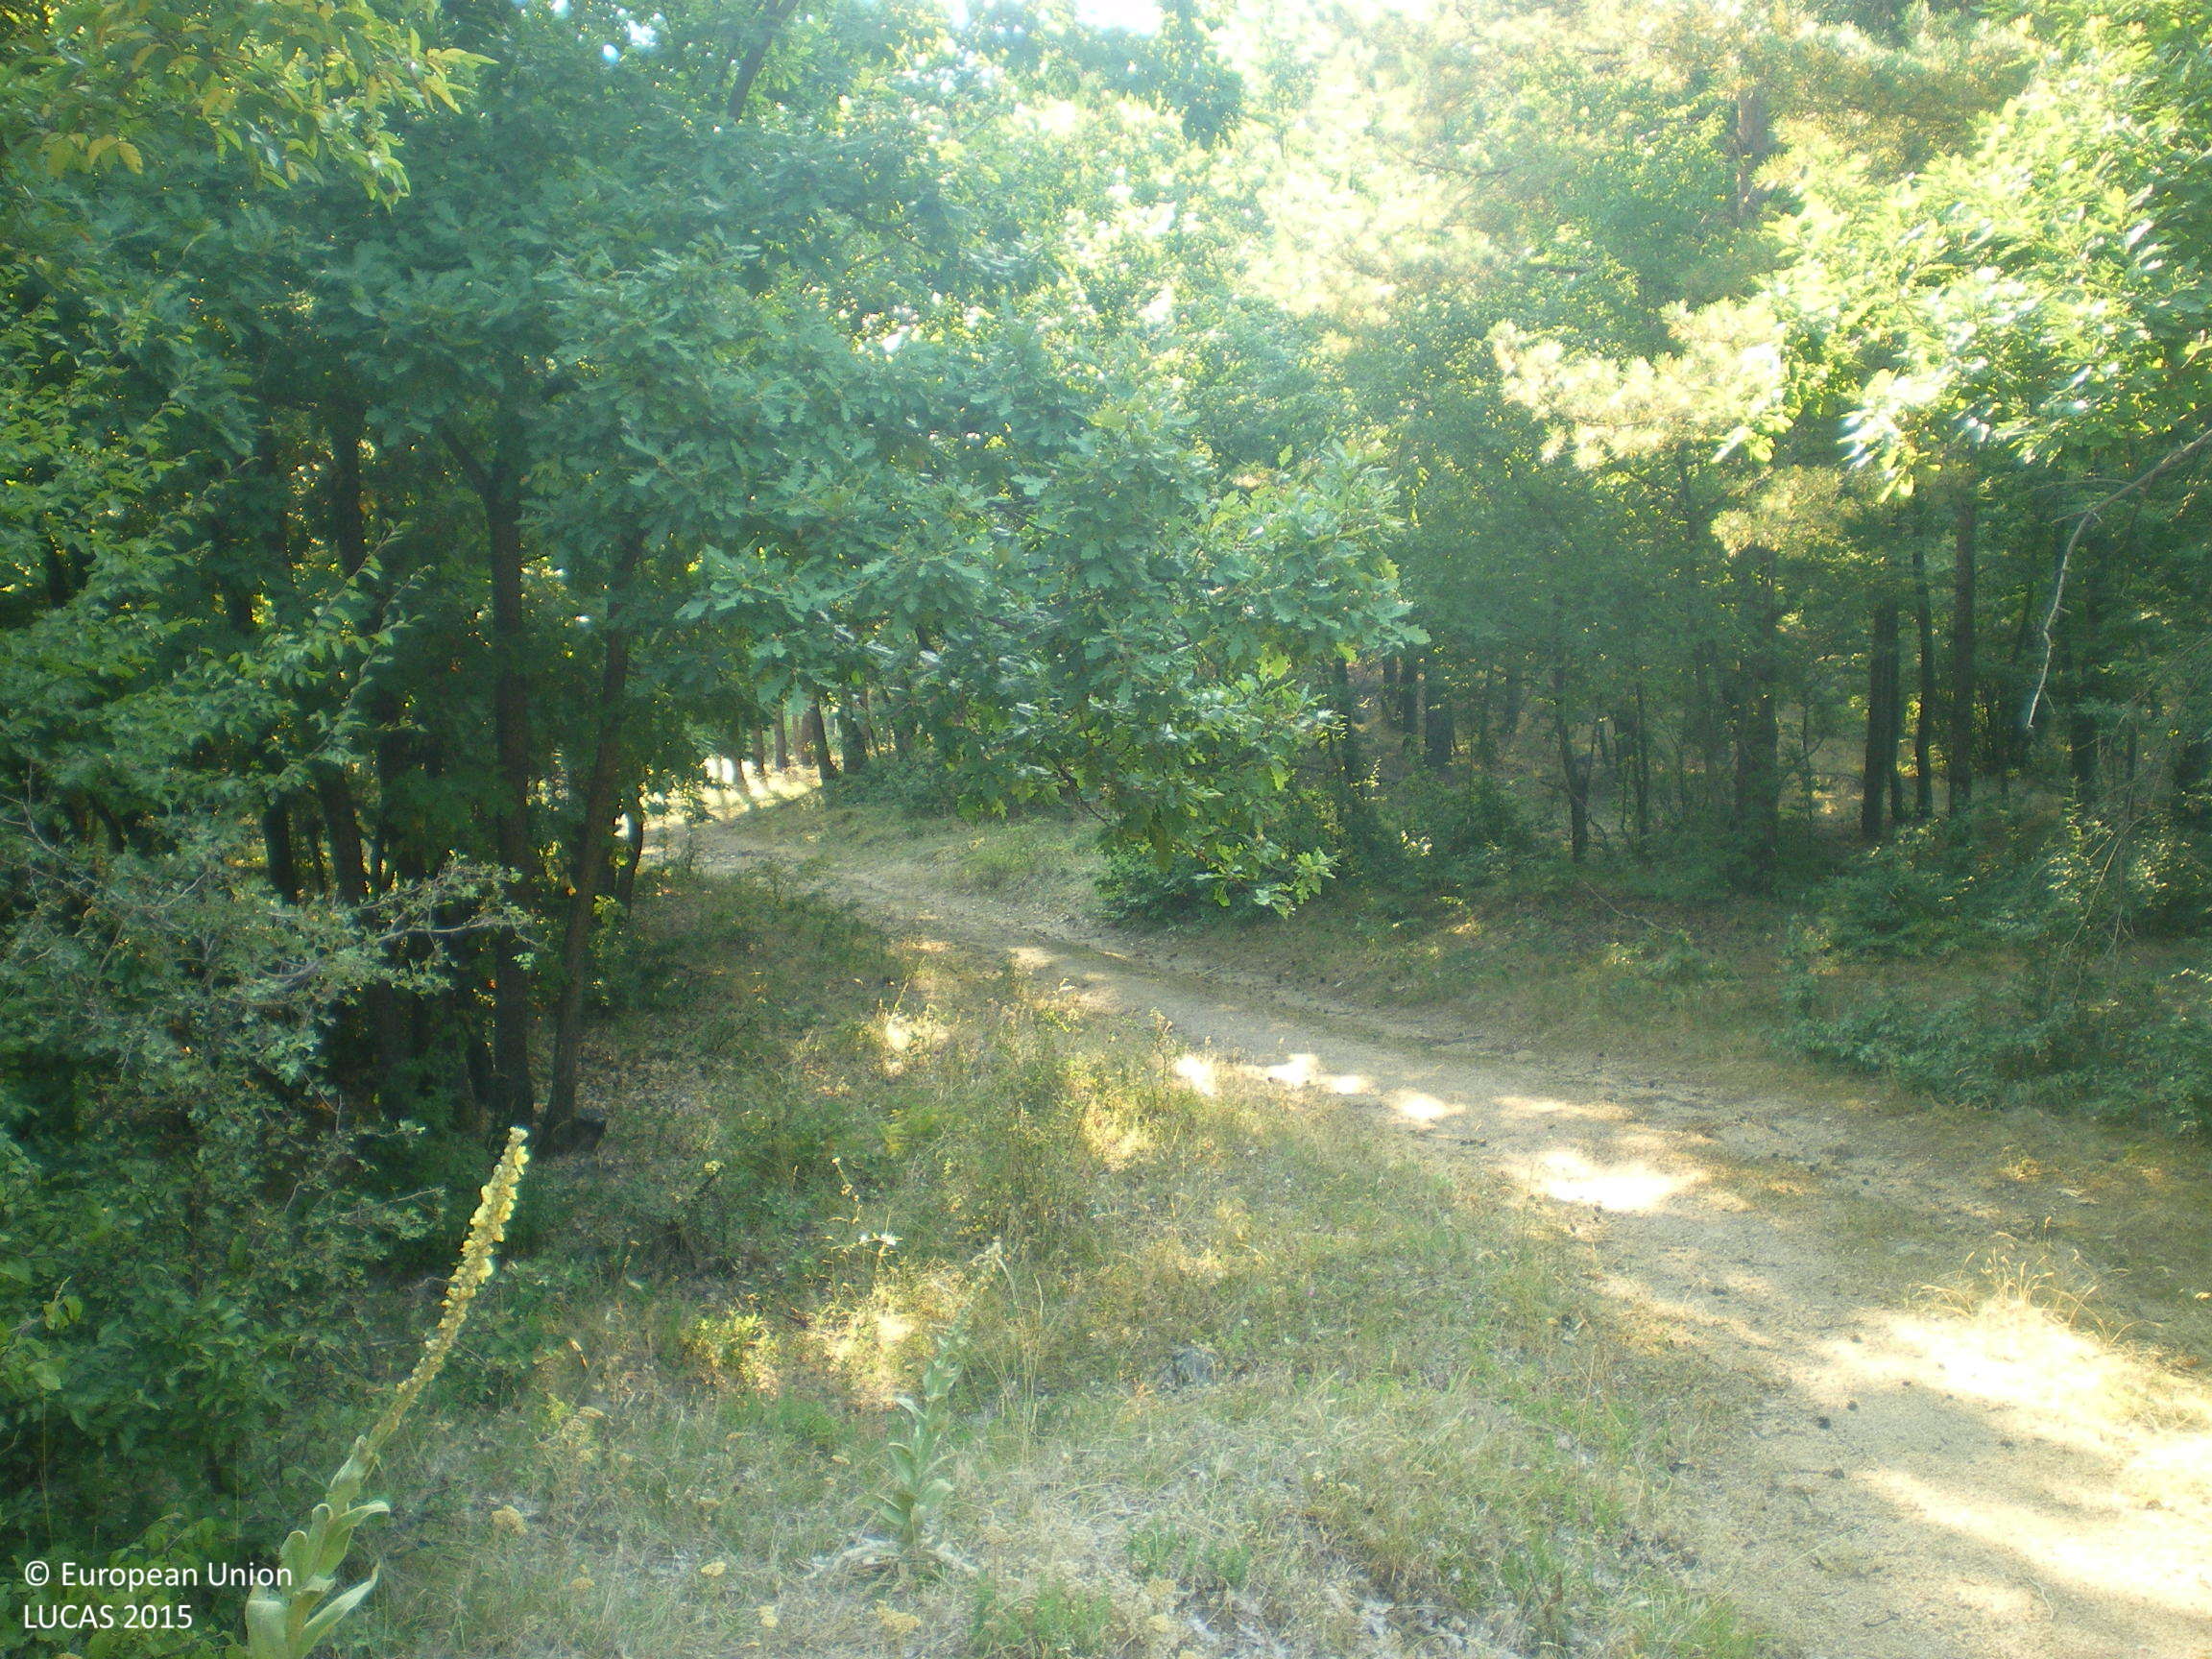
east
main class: Woodland
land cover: Broadleaved woodland
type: mesophytic deciduous forest
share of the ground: > 75 %
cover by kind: broadleaved forest trees 65 %, herbaceous plants 20 %, shrubs 15 %
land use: Forestry
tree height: > 5 m
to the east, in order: Broadleaved woodland; Tracks; Pine dominated mixed woodland; Tracks; Pine dominated mixed woodland
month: July
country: BG
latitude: 42.6404
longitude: 25.0515
